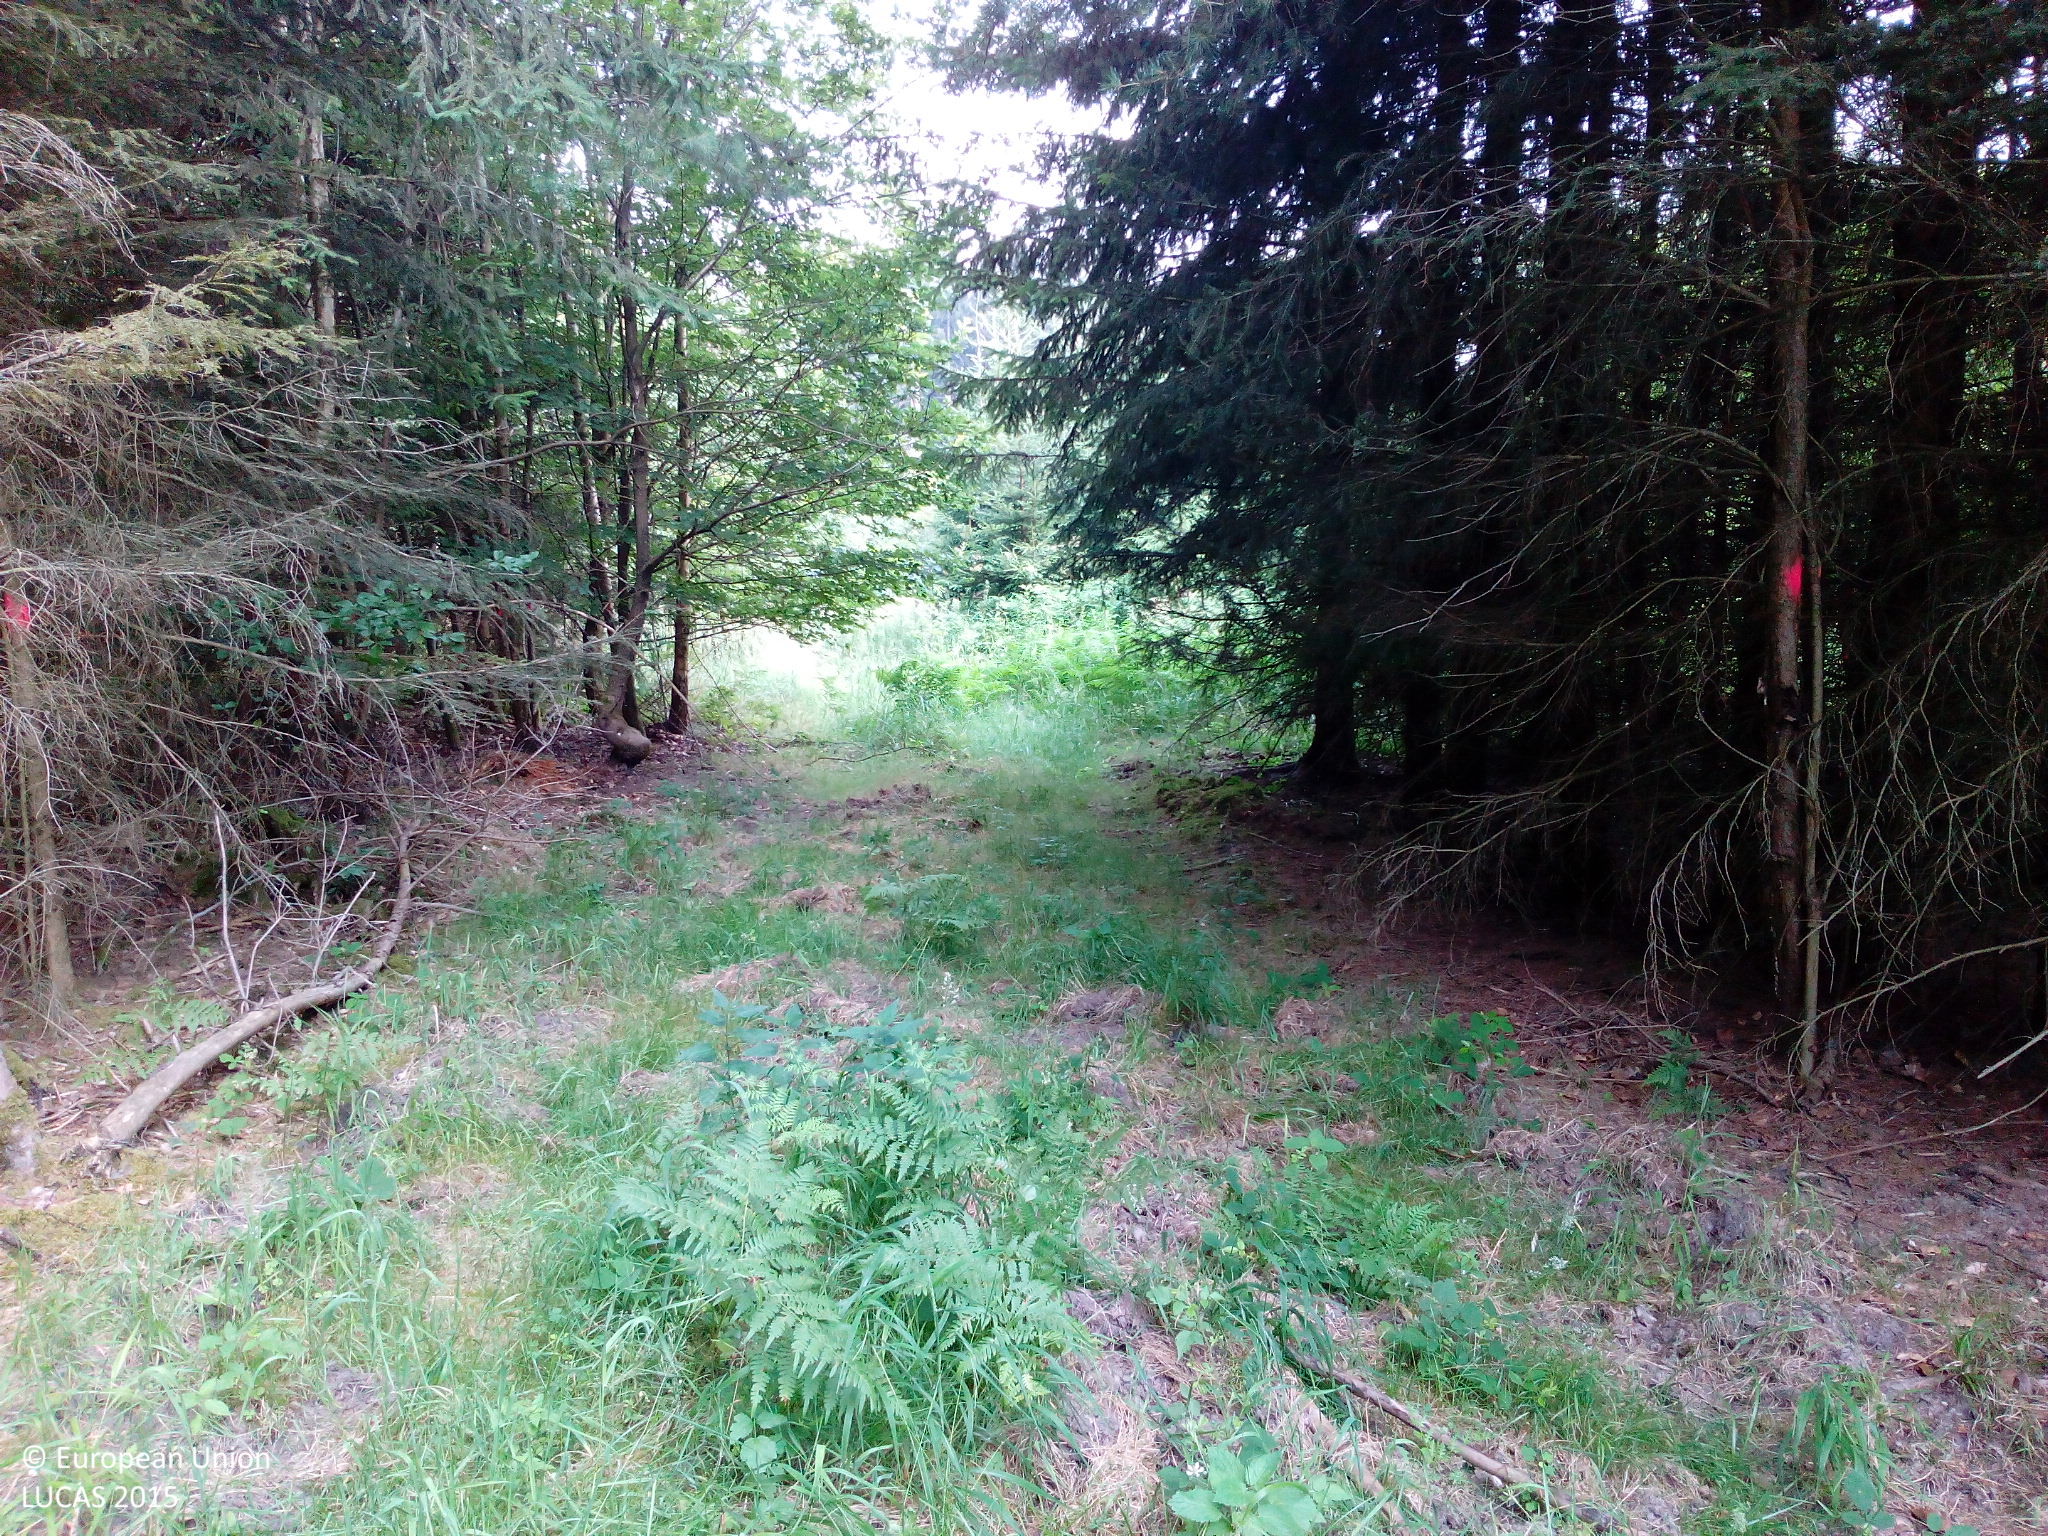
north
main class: Woodland
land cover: Spruce dominated coniferous woodland
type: hemiboreal forest and nemoral coniferous forest and mixed broadleaved-coniferous forest
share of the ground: > 75 %
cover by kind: coniferous forest trees 95 %, consolidated bare surface 5 %
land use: Forestry
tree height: > 5 m
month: July
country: DE
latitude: 48.9057
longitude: 12.0867
